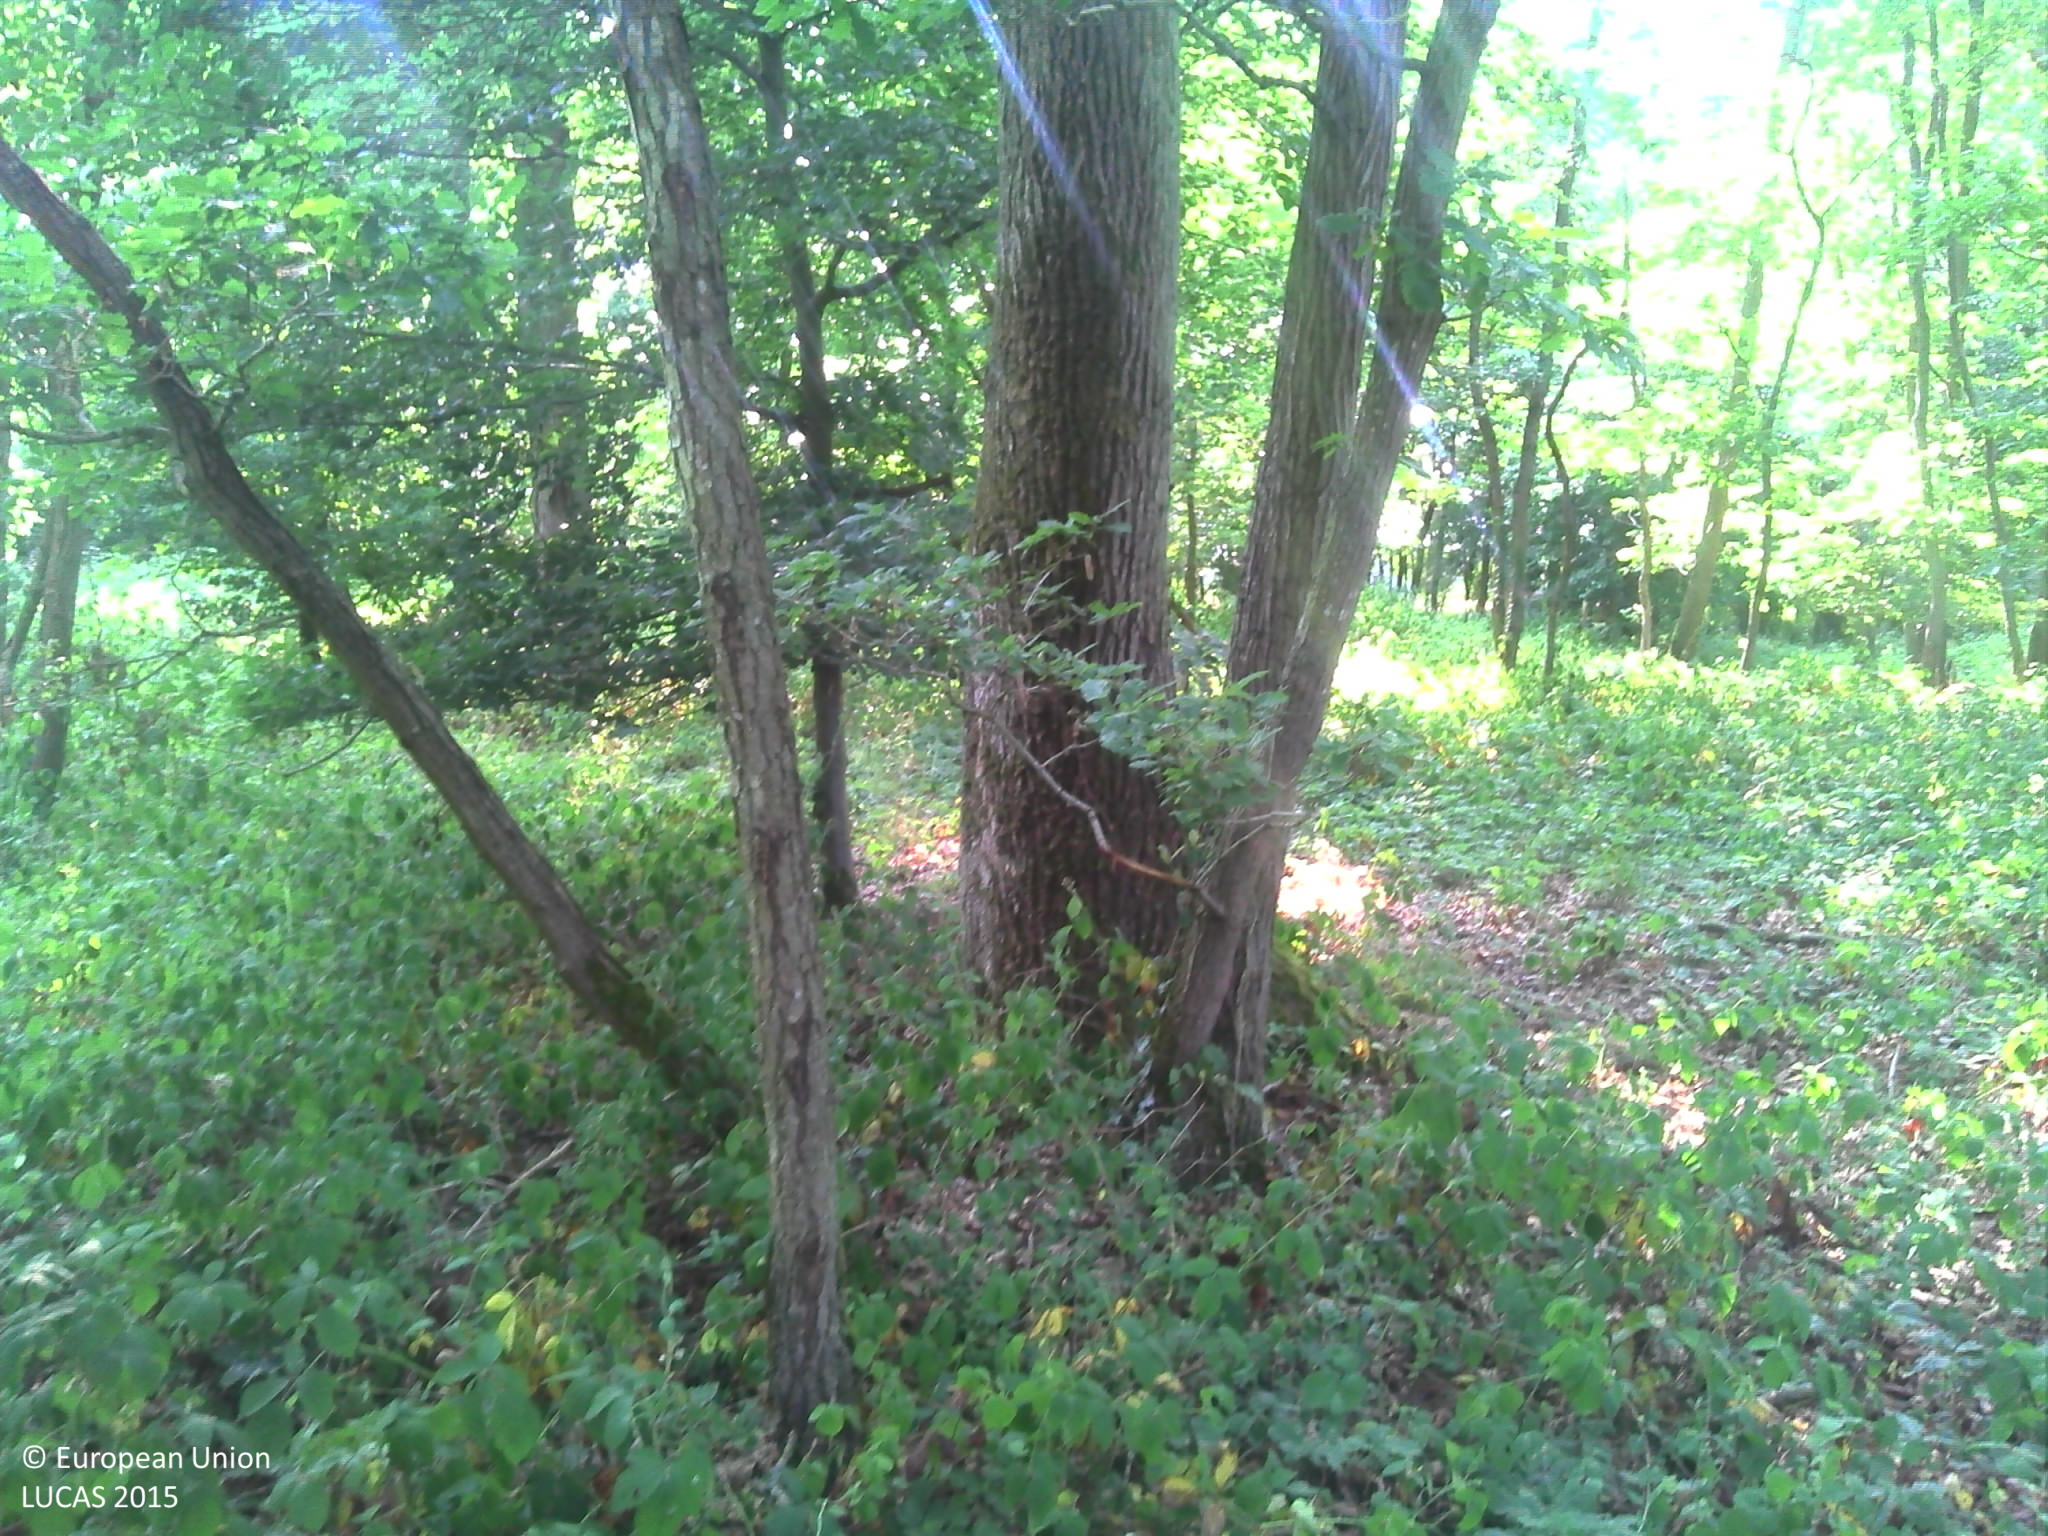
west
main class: Woodland
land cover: Broadleaved woodland
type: acidophilous oak and oak-birch forest
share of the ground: > 75 %
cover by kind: broadleaved forest trees 60 %, herbaceous plants 30 %, lichens and mosses 10 %
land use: Forestry
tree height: > 5 m
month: July
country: FR
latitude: 48.7227
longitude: 1.2128
